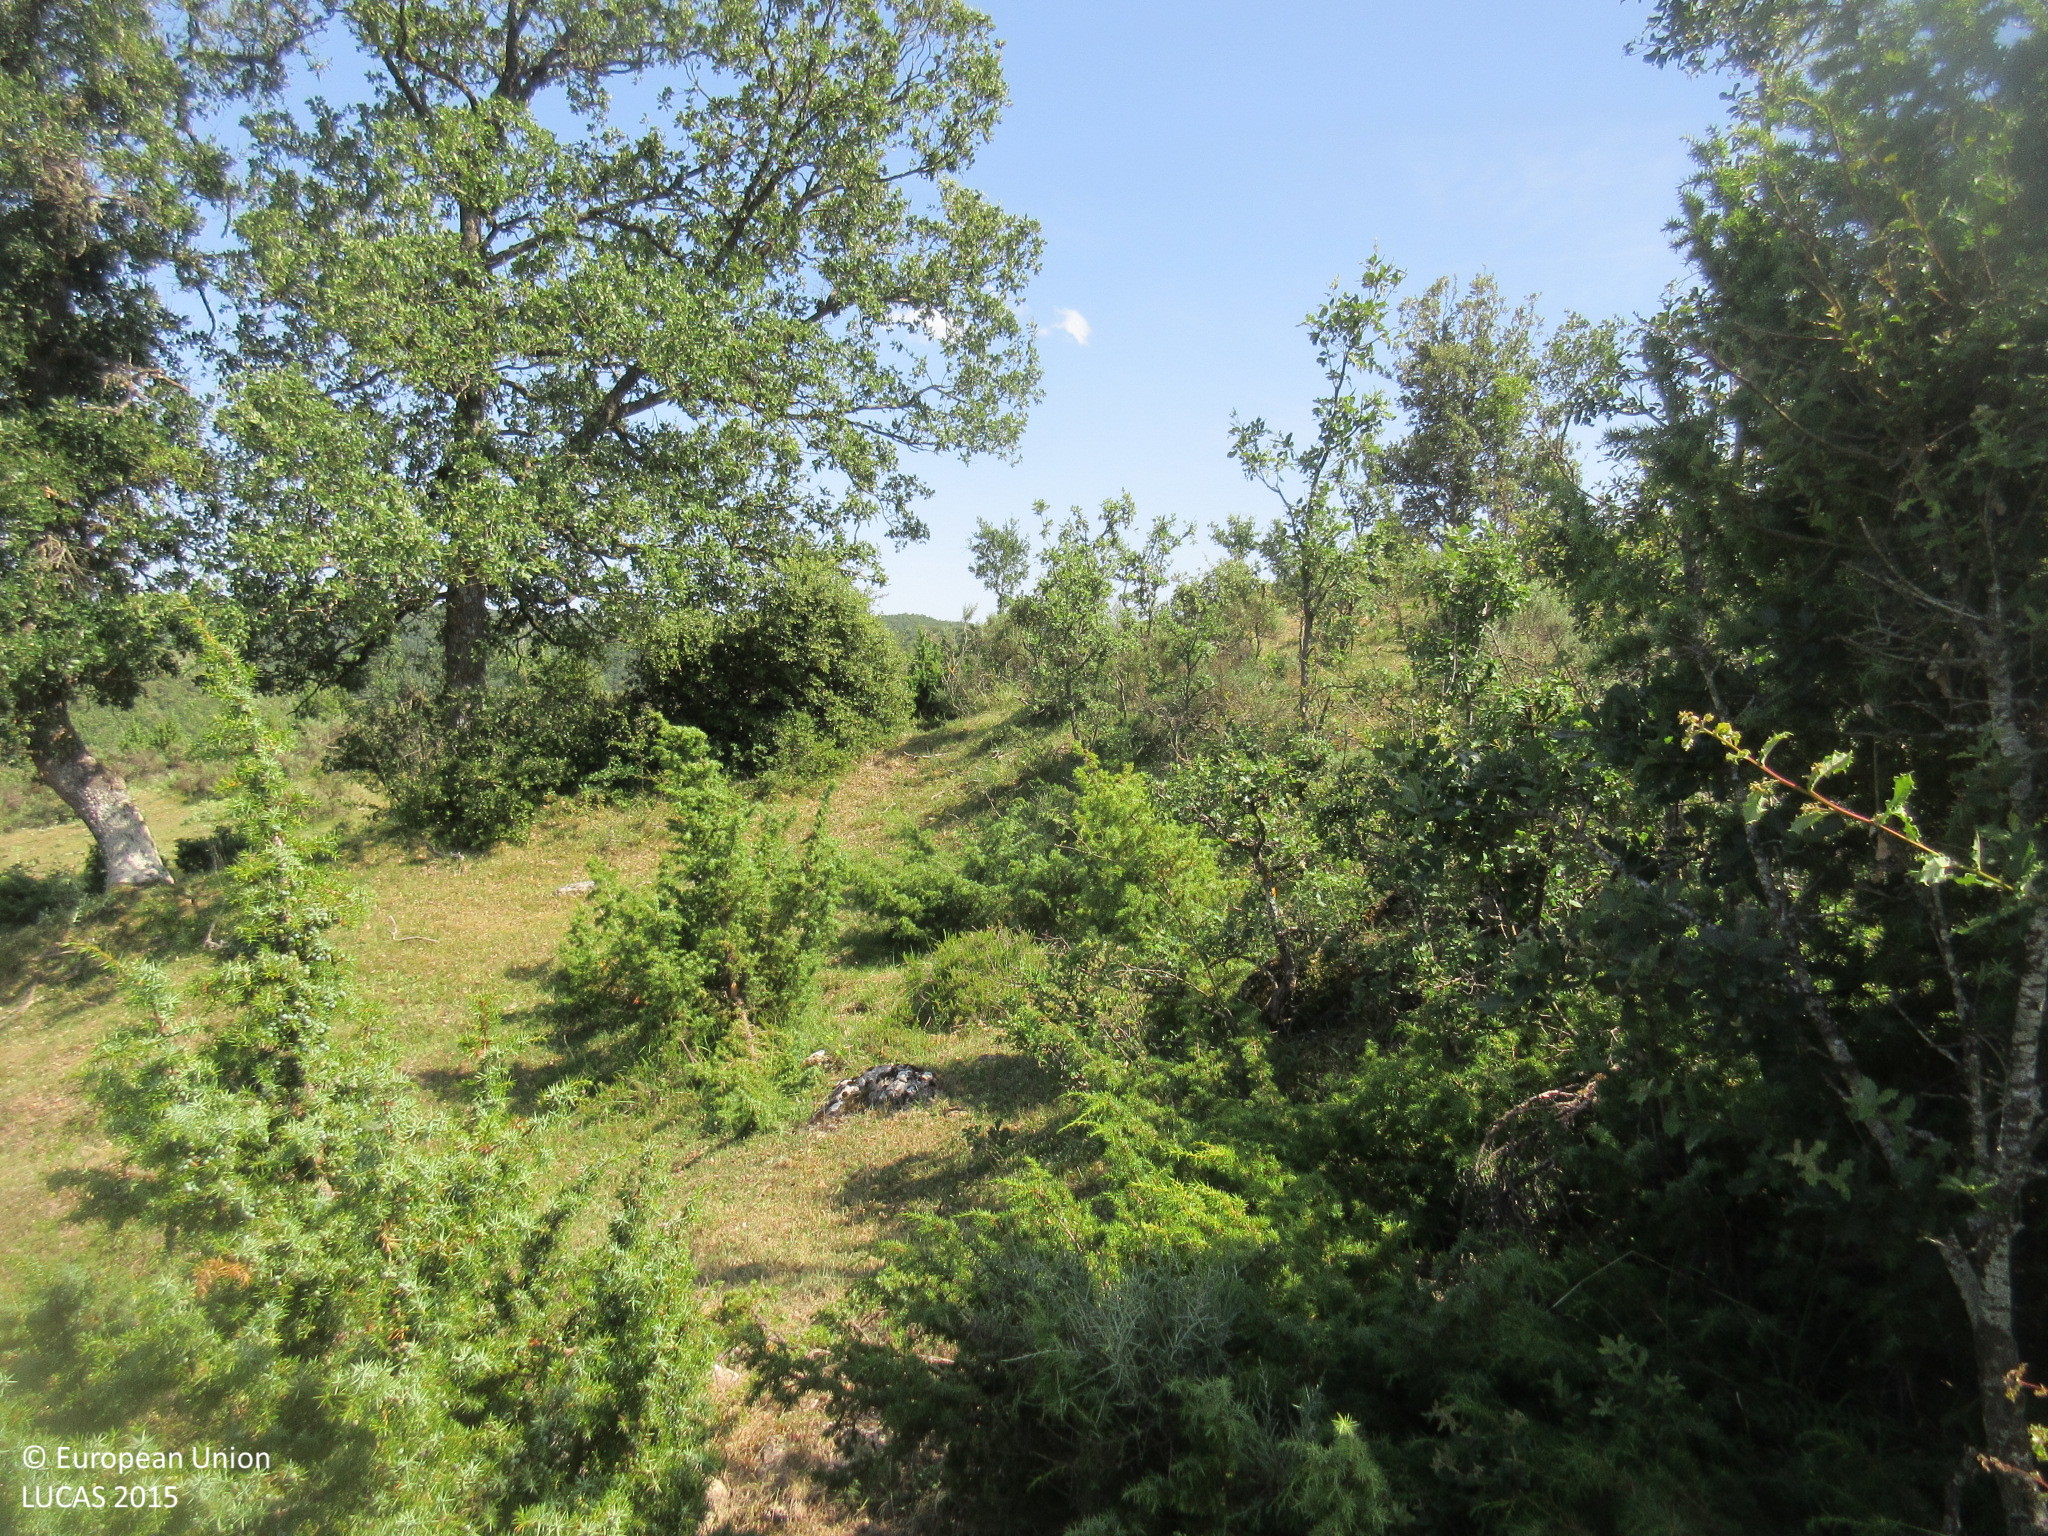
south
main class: Grassland
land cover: Grassland with sparse tree/shrub cover
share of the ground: > 75 %
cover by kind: herbaceous plants 90 %, broadleaved forest trees 5 %, shrubs 5 %
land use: Agriculture (excluding fallow land and kitchen gardens)
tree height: > 5 m
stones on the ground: 10 - 25 %
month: July
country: ES
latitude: 42.9427
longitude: -3.4334
